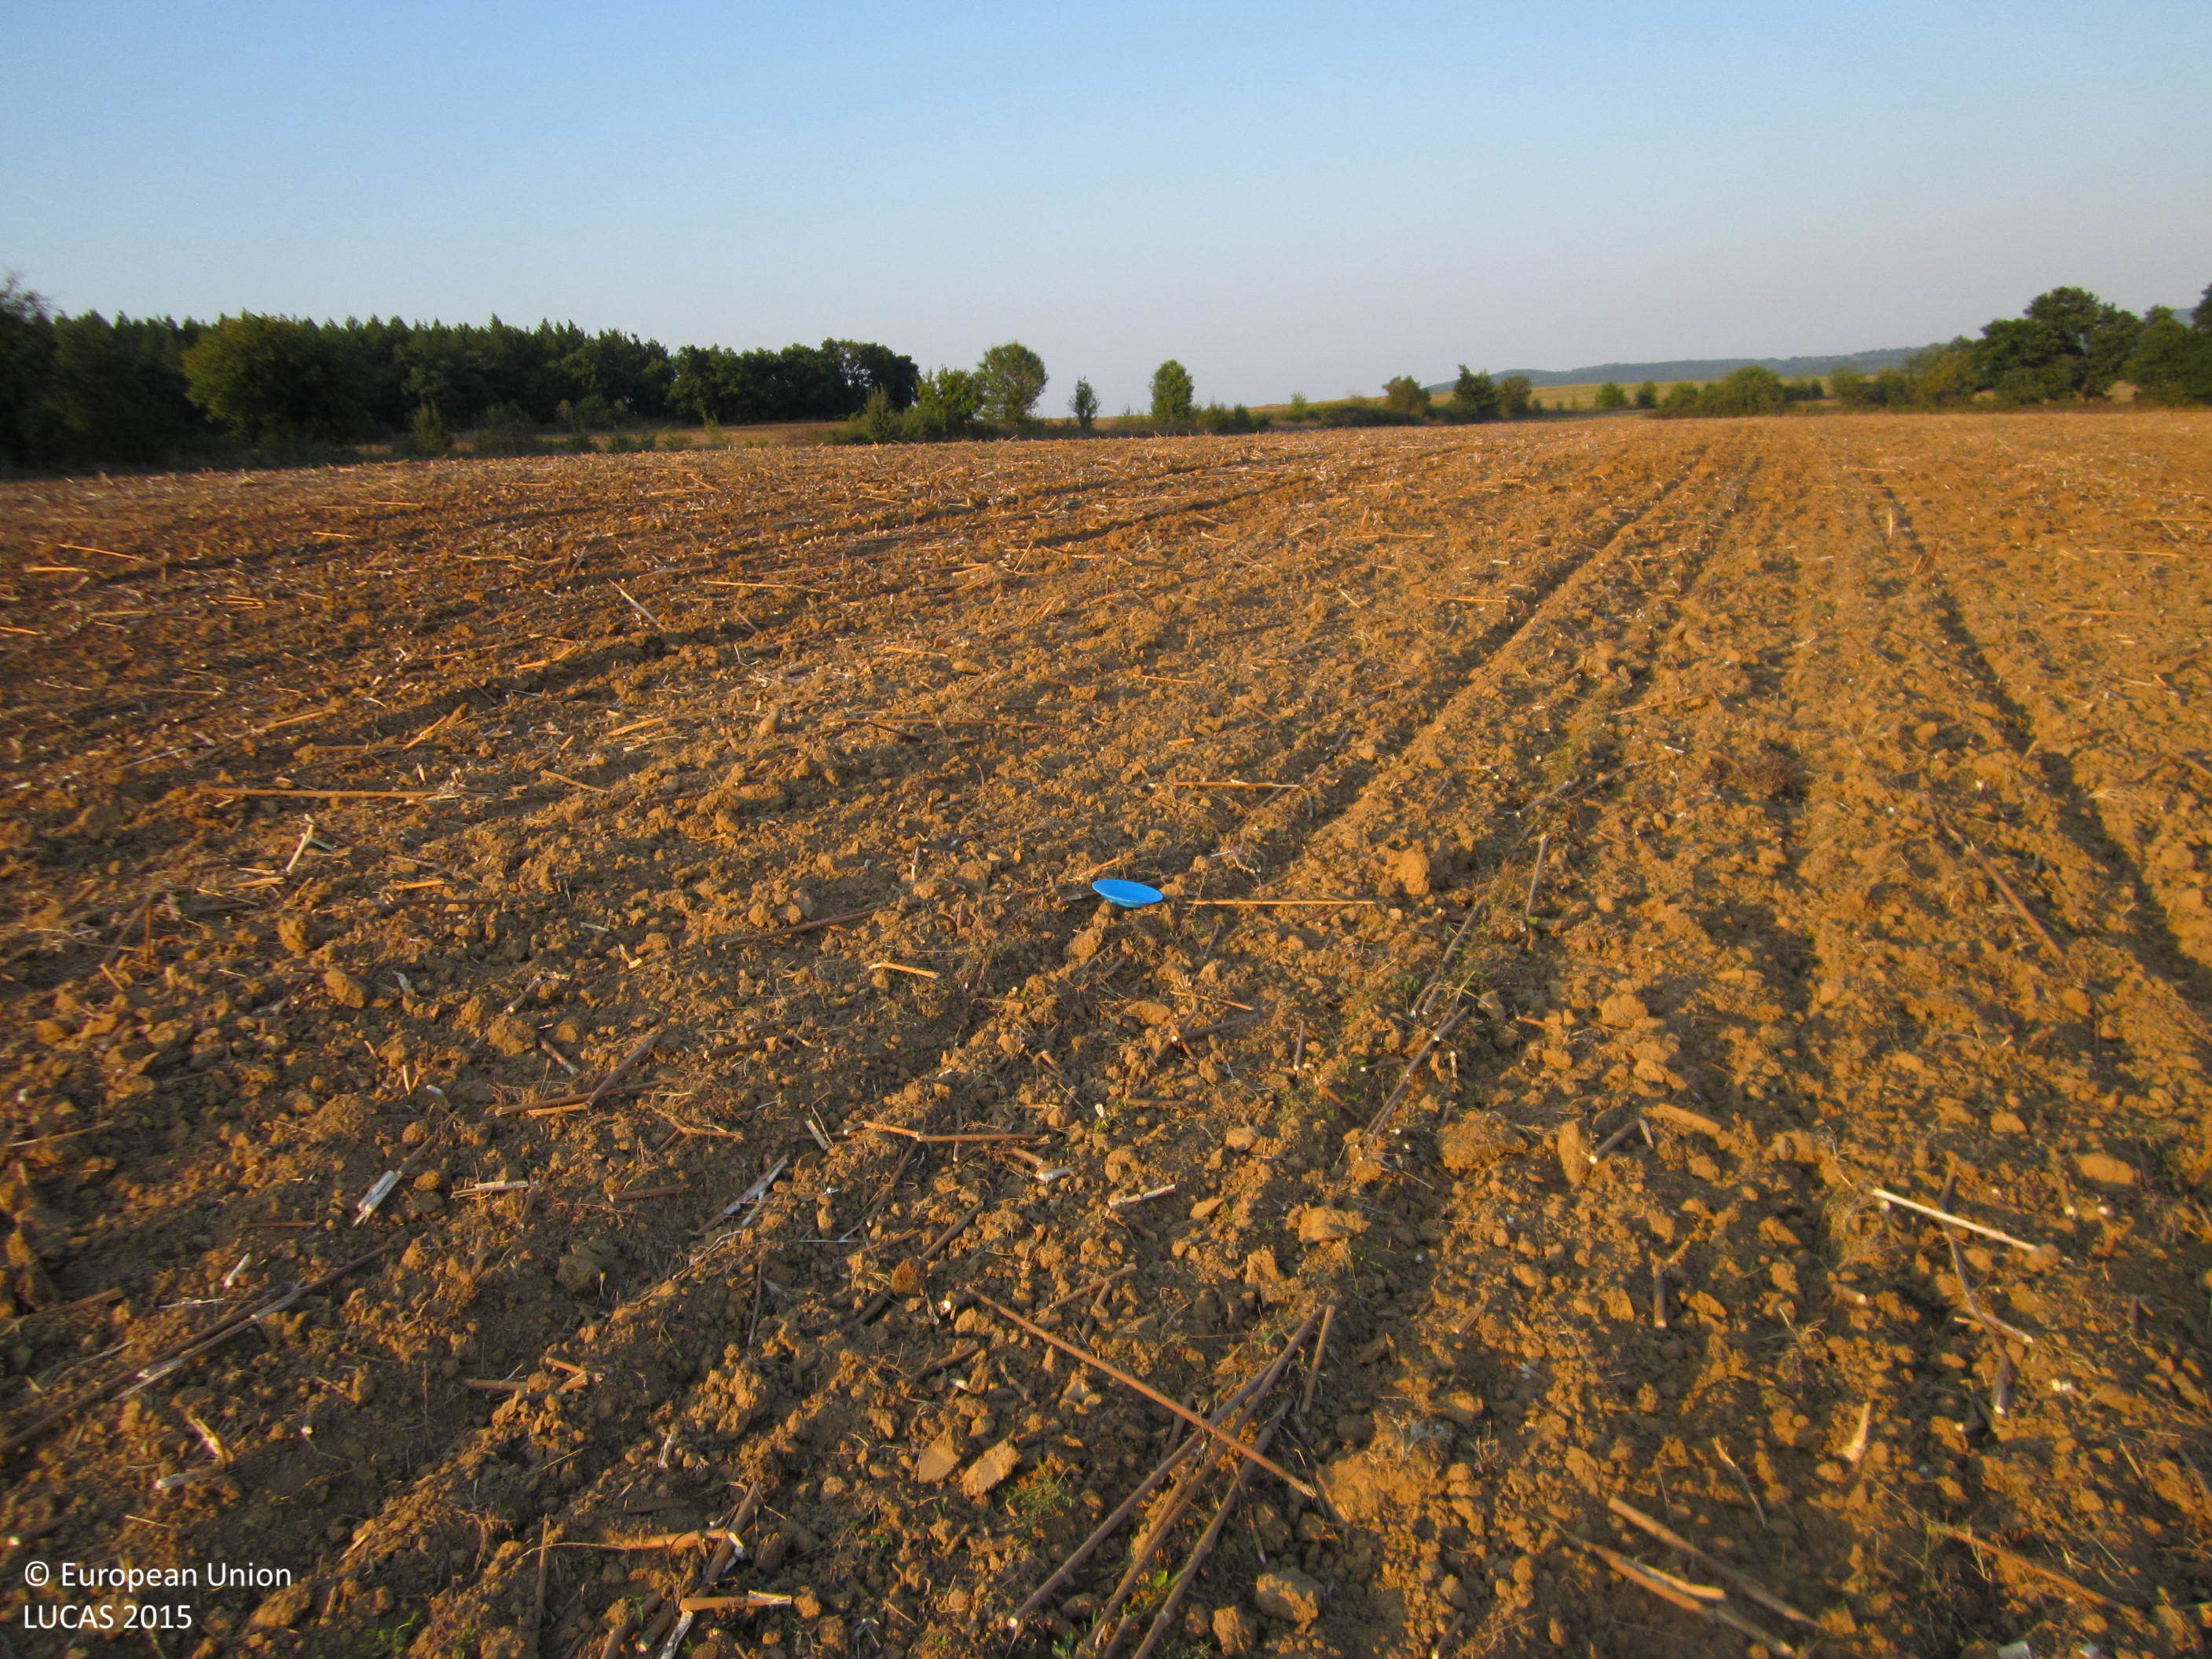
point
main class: Cropland
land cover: Sunflower
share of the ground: < 10 %
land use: Agriculture (excluding fallow land and kitchen gardens)
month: September
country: BG
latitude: 42.8258
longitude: 27.1022
